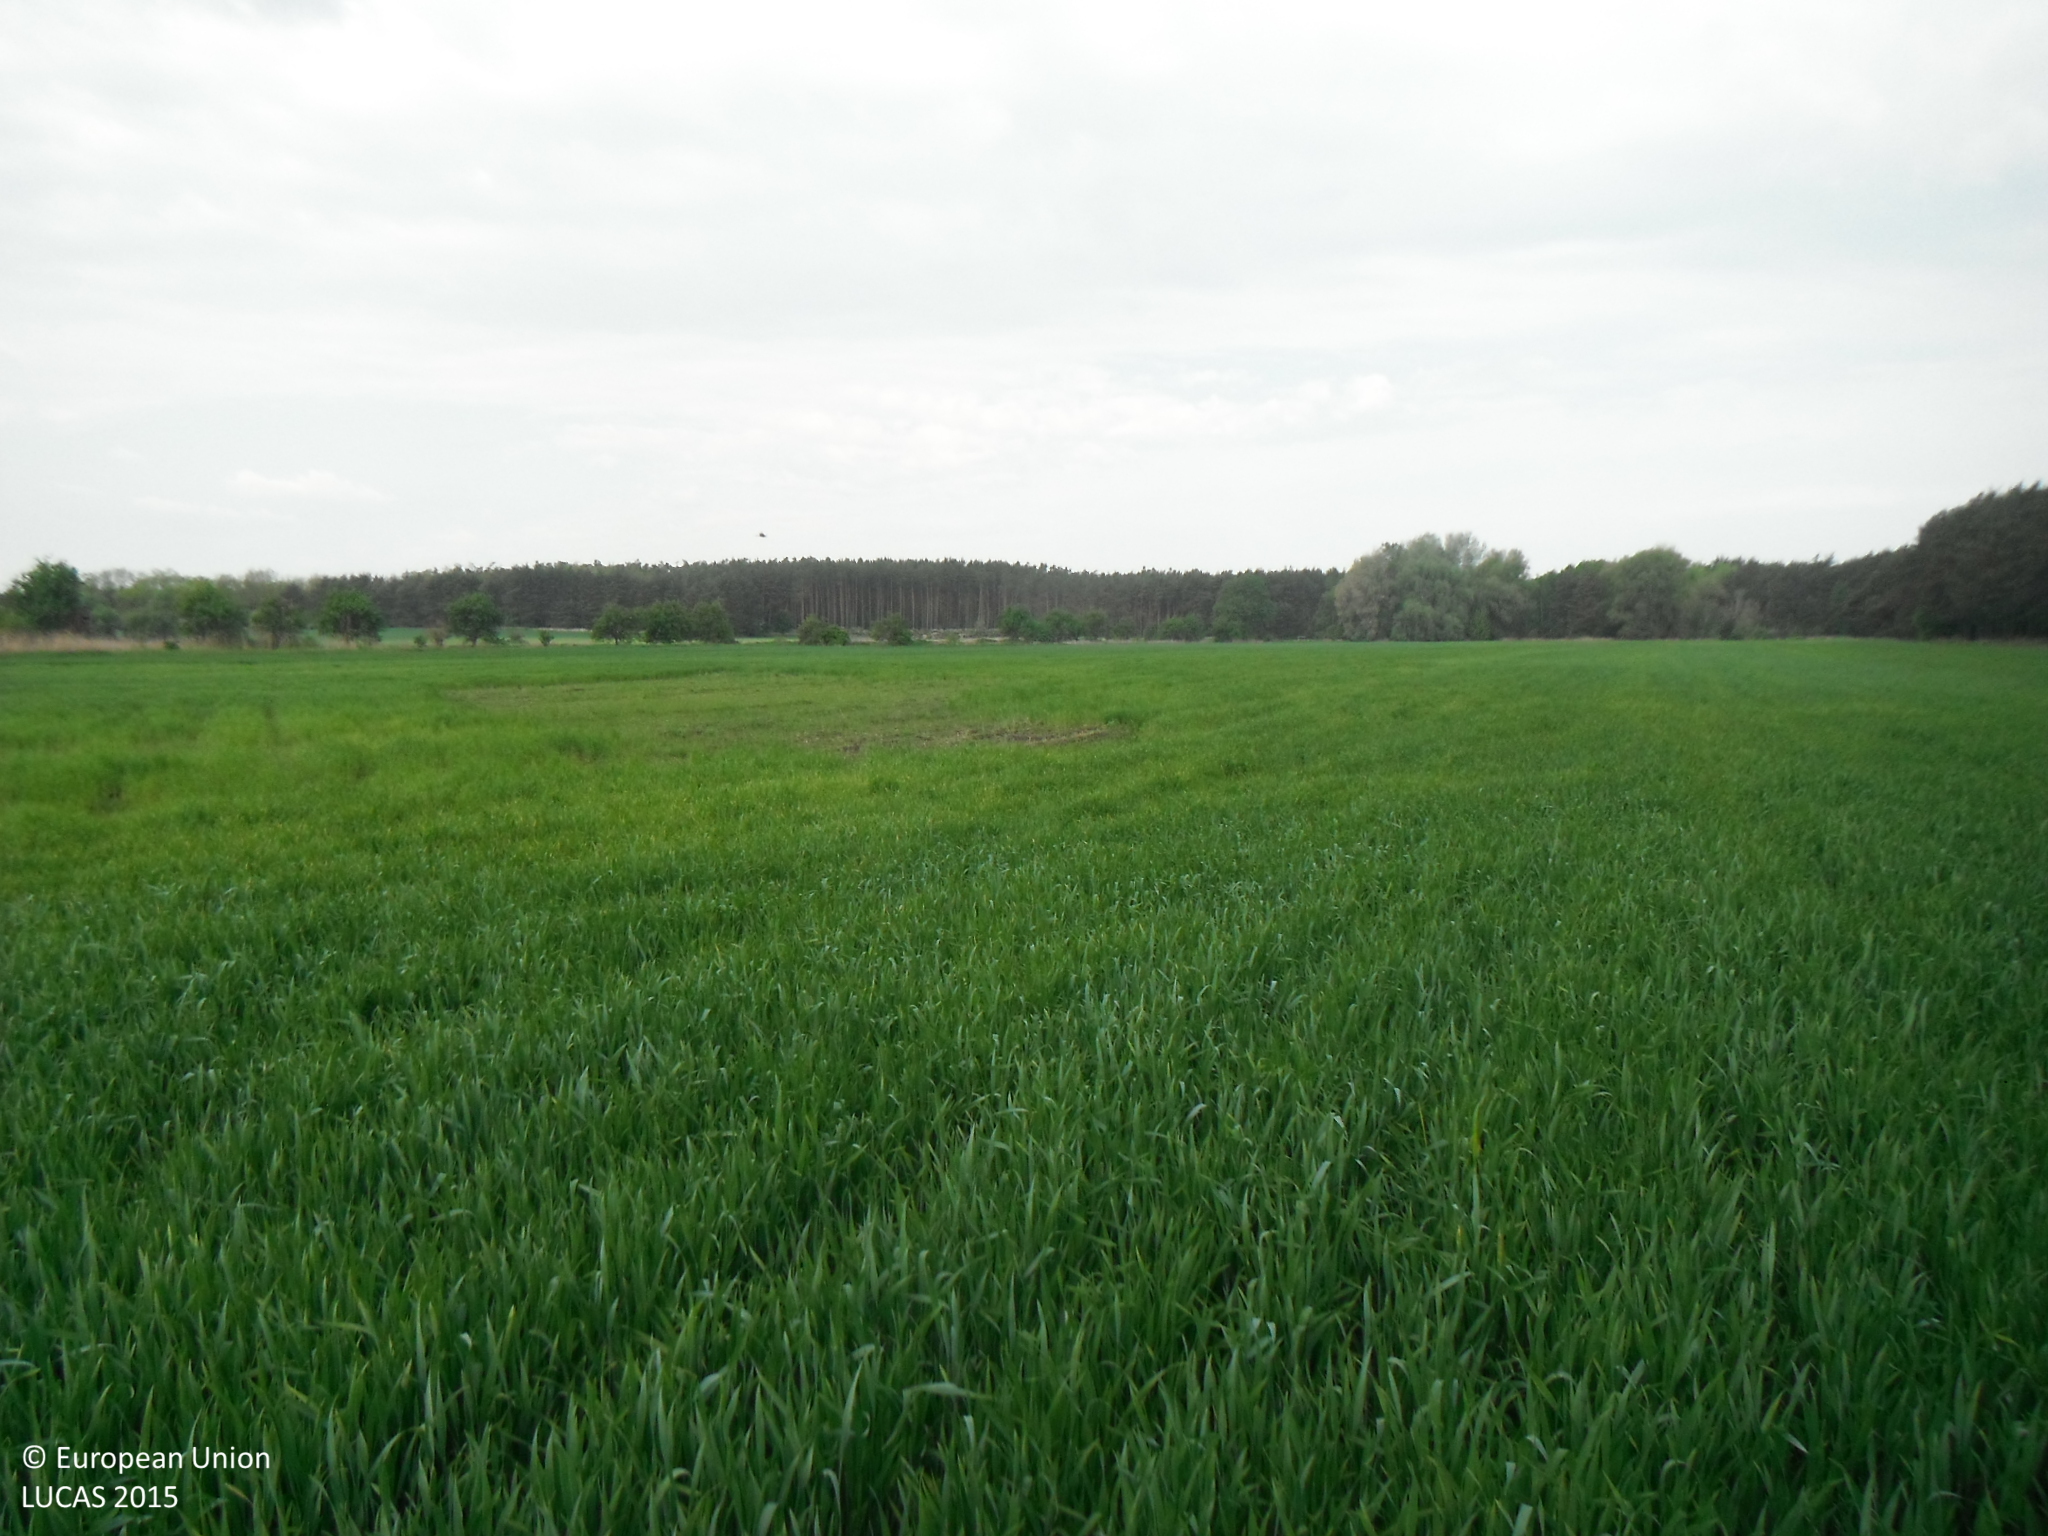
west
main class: Cropland
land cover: Common wheat
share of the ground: > 75 %
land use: Agriculture (excluding fallow land and kitchen gardens)
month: May
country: SK
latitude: 48.4704
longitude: 17.0009
